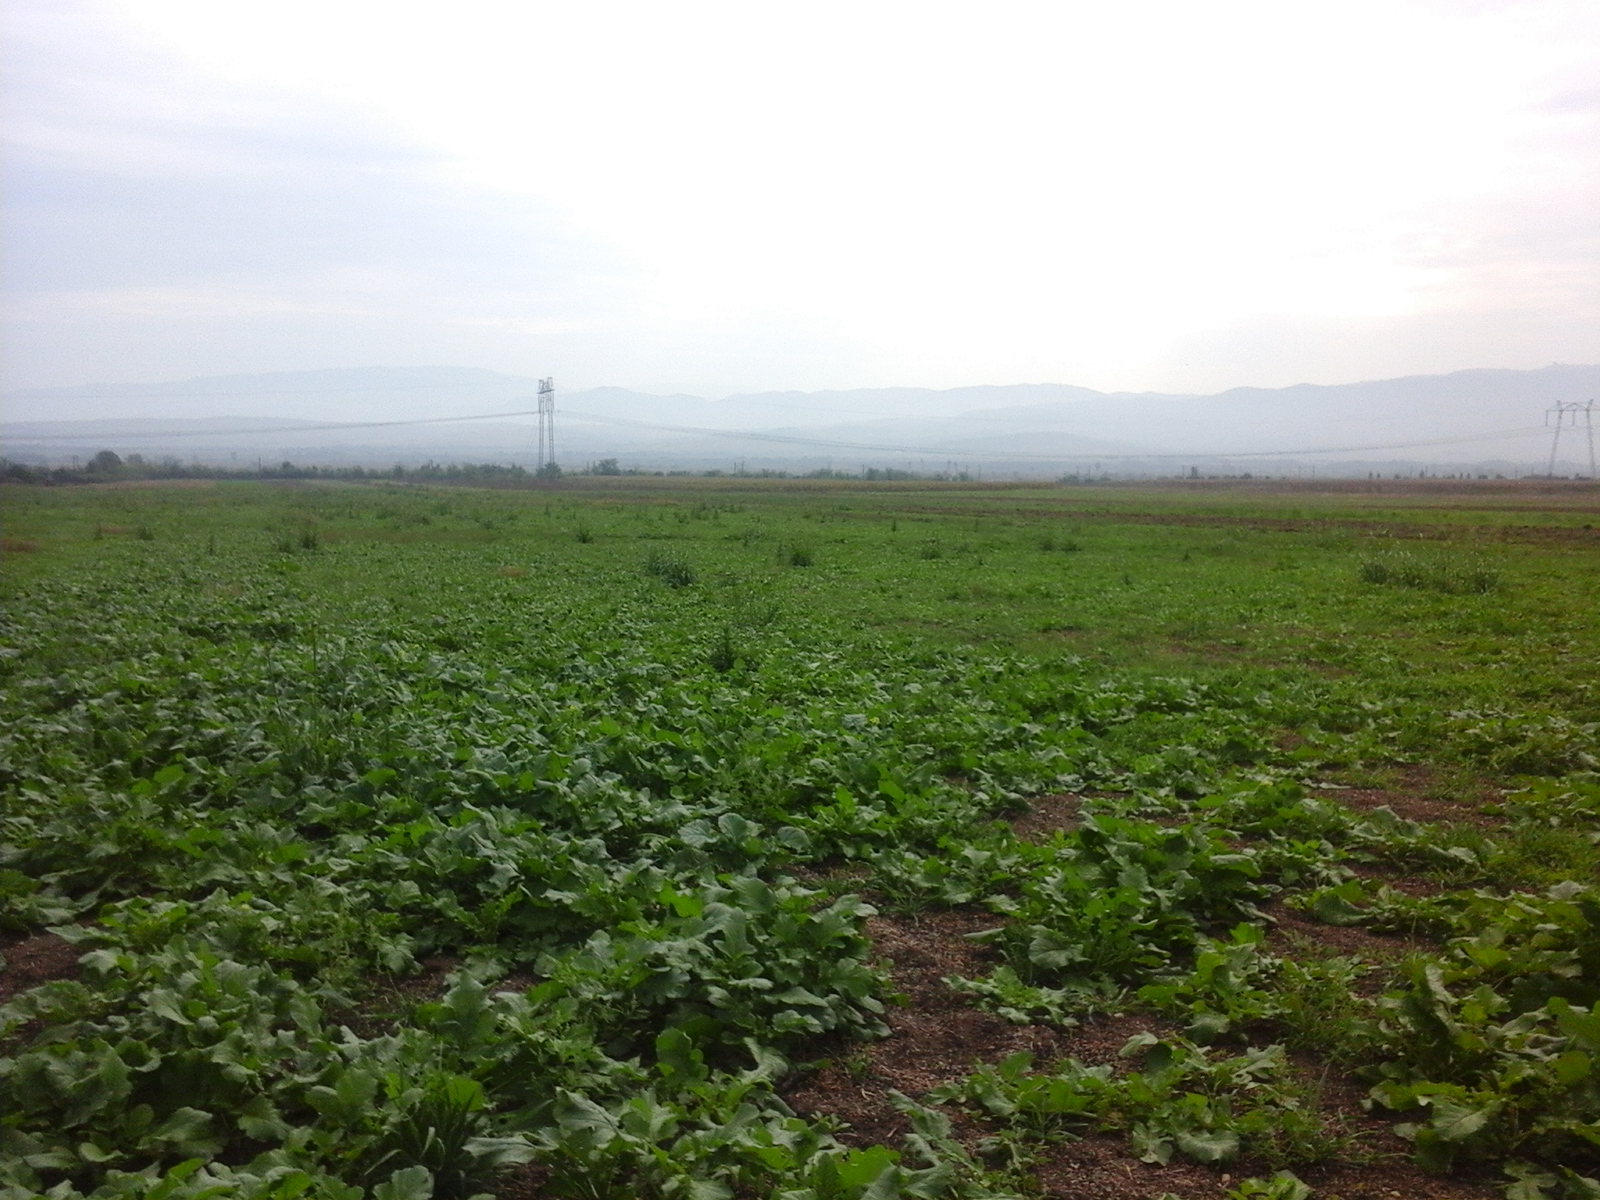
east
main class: Cropland
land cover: Sugar beet
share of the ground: > 75 %
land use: Agriculture (excluding fallow land and kitchen gardens)
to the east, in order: Sugar beet; Tracks; Sugar beet; Spontaneously vegetated surfaces
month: September
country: RO
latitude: 45.6836
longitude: 22.9831
